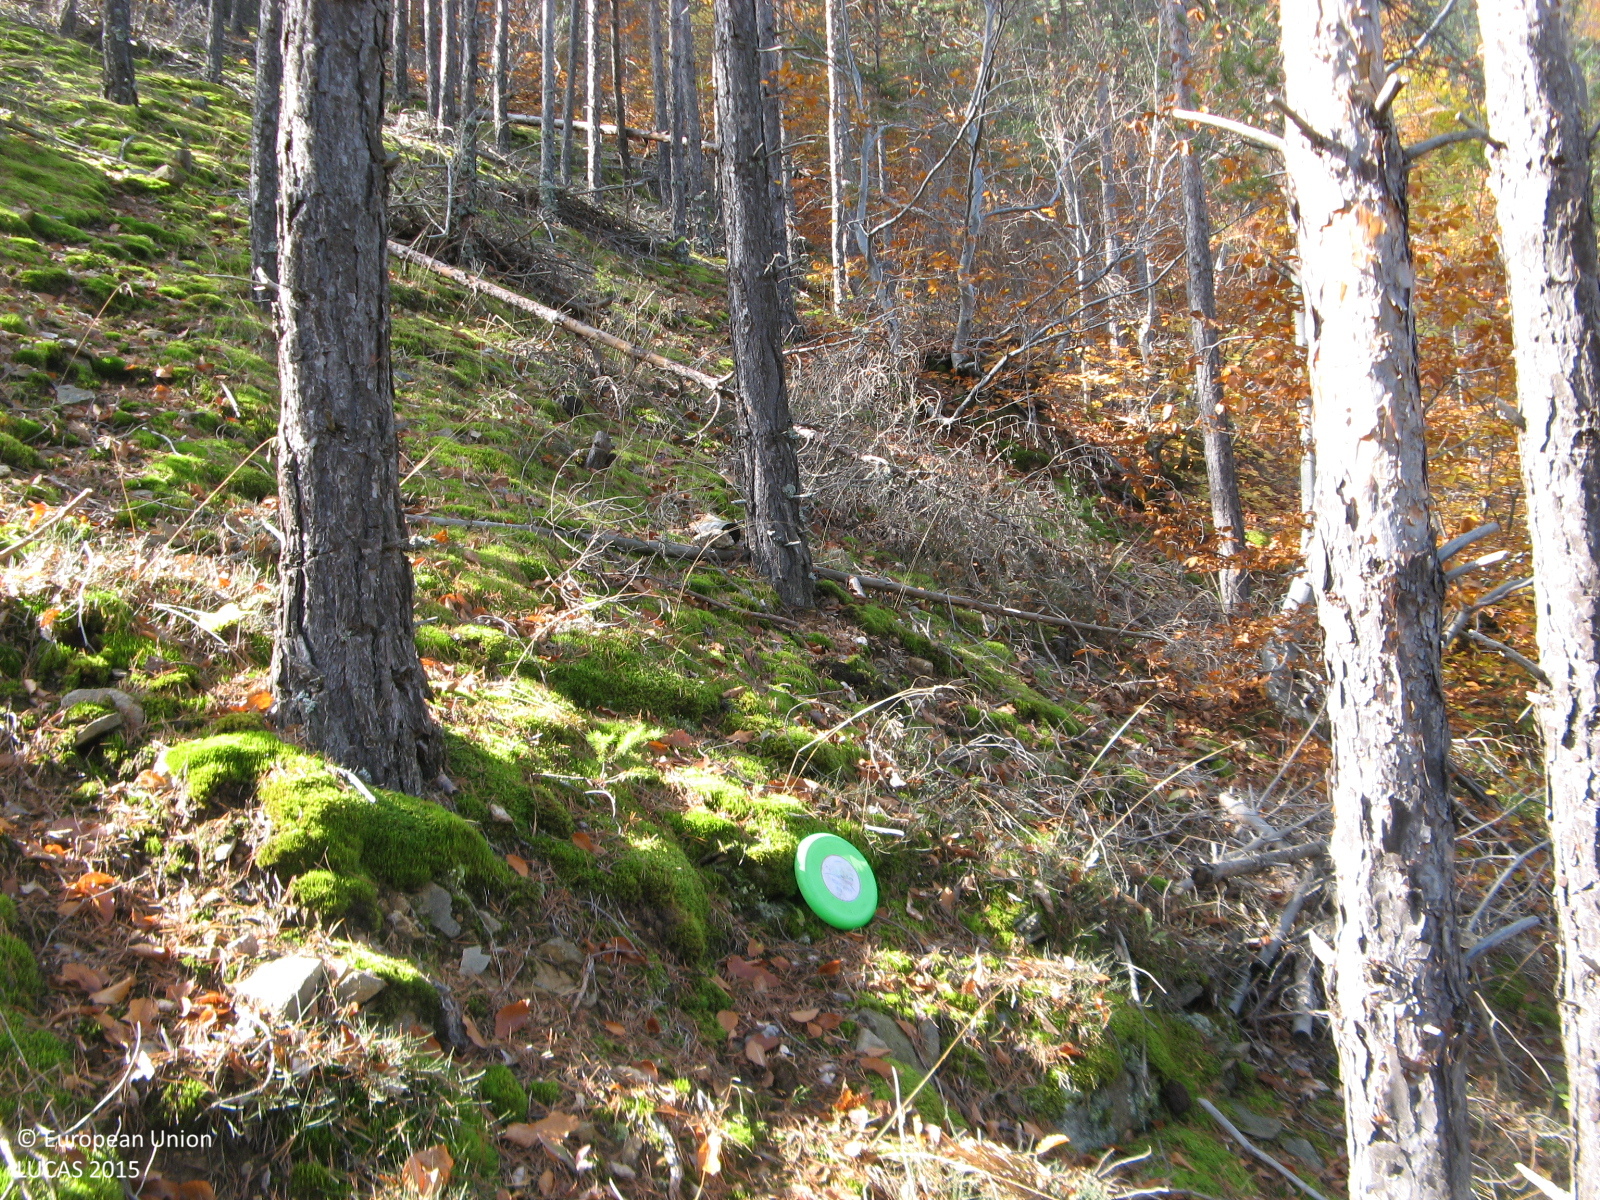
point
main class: Woodland
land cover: Pine dominated mixed woodland
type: alpine coniferous forest
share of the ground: > 75 %
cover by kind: coniferous forest trees 70 %, broadleaved forest trees 25 %, lichens and mosses 5 %
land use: Forestry
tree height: > 5 m
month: October
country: BG
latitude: 41.5343
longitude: 24.8483
